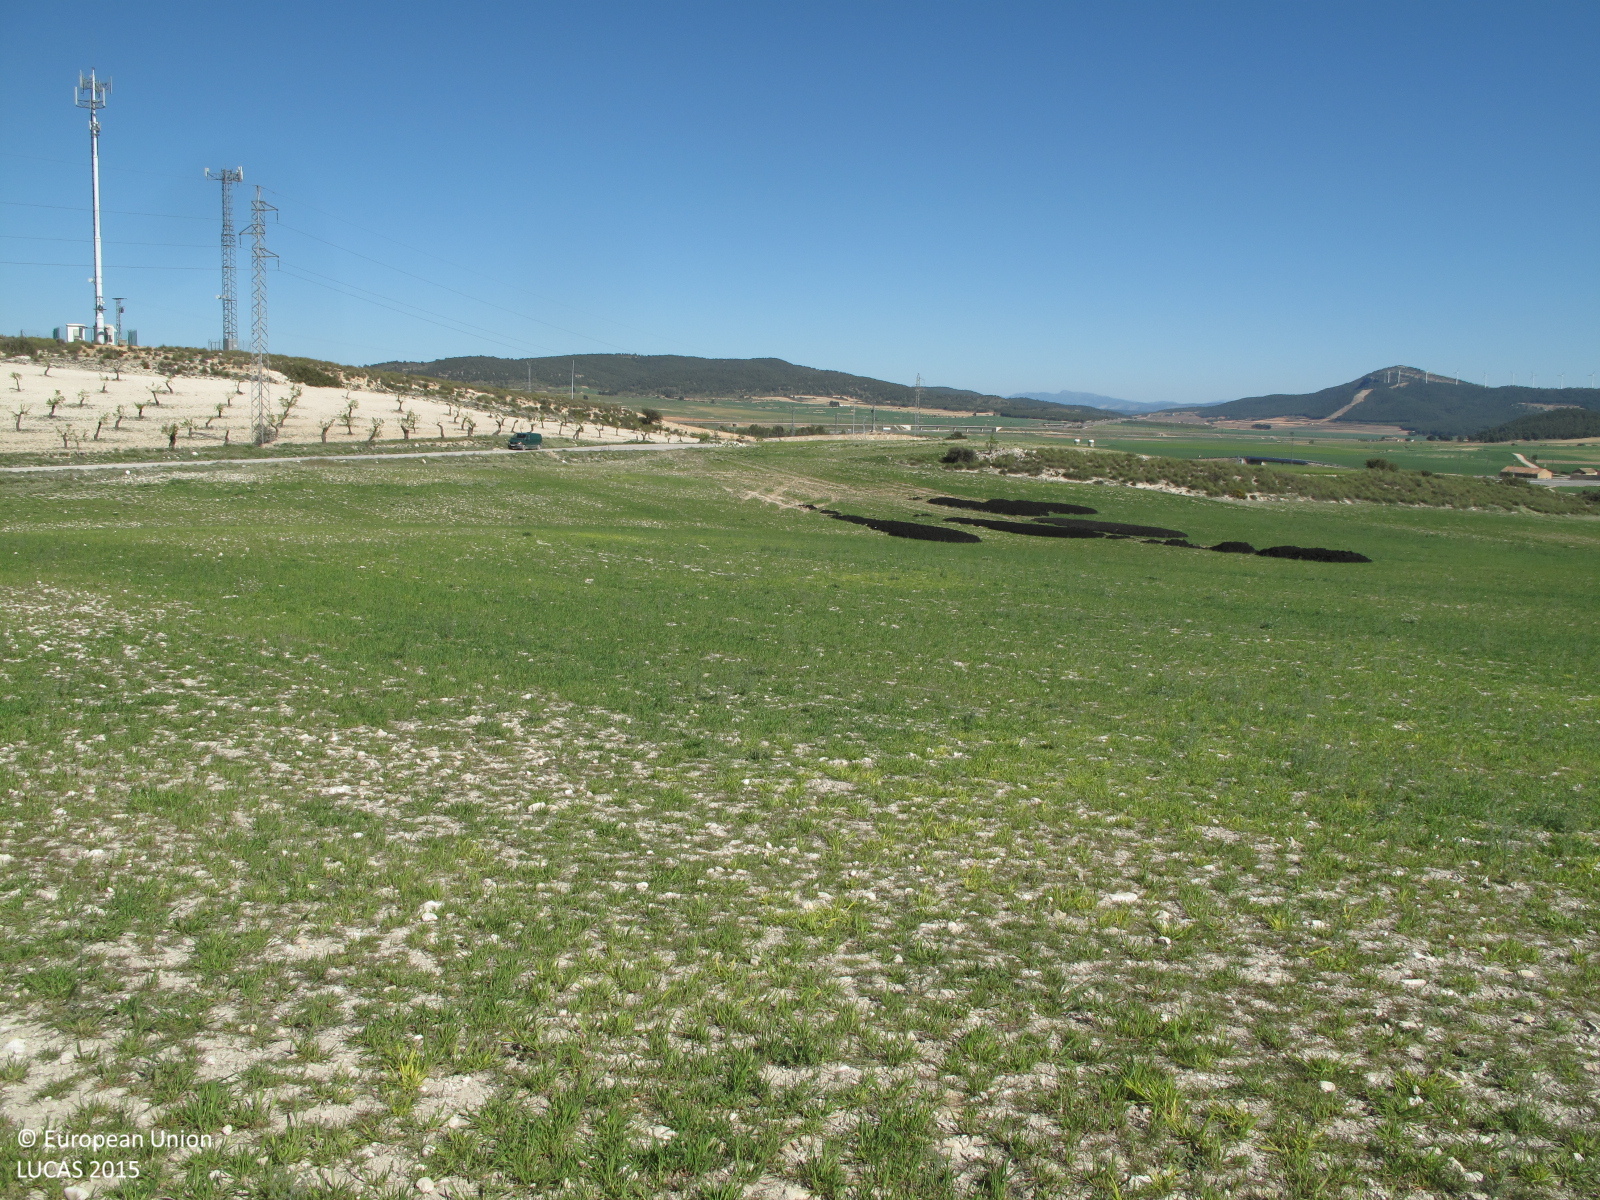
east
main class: Grassland
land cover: Spontaneously vegetated surfaces
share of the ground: 50 - 75 %
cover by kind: herbaceous plants 70 %, unconsolidated bare surface 30 %
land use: Fallow land
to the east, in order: Spontaneously vegetated surfaces; Paved roads, cycling and walking lanes; Shruby margins; Nuts trees; Electric lines
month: March
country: ES
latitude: 38.8415
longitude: -1.0190
